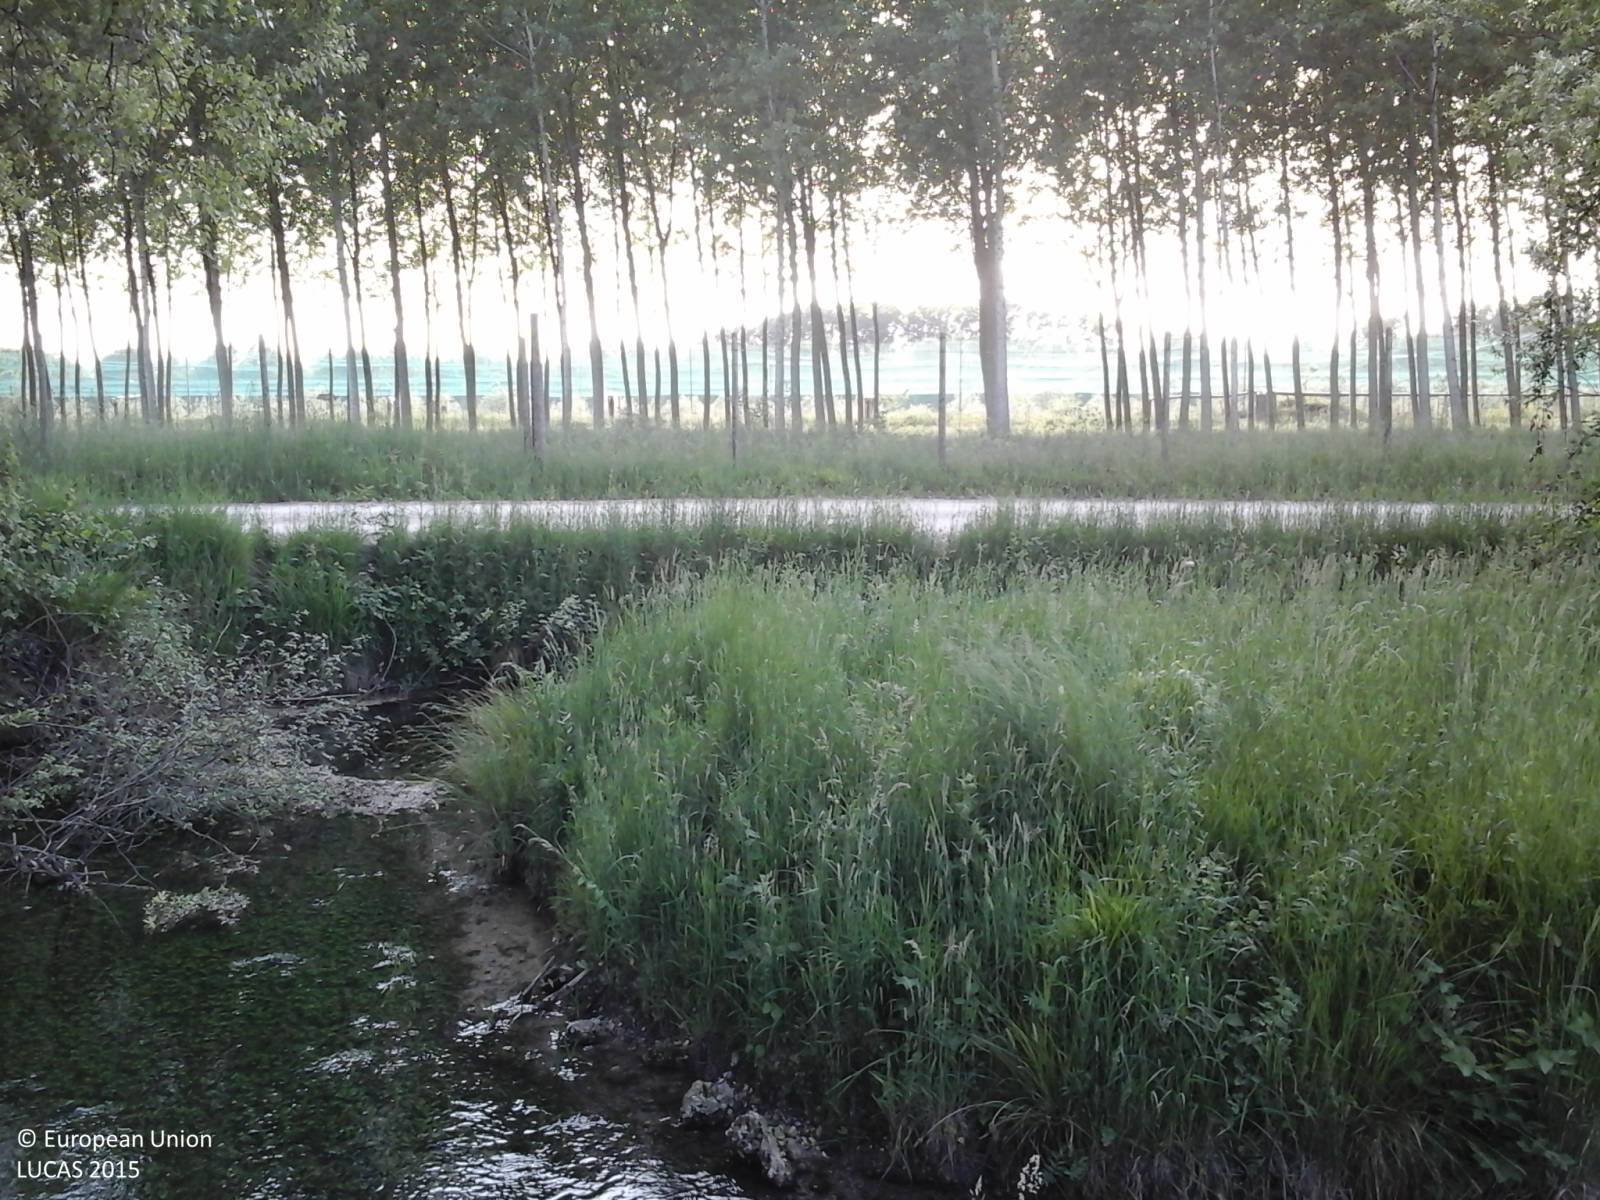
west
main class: Woodland
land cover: Broadleaved woodland
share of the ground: > 75 %
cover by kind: broadleaved forest trees 90 %, herbaceous plants 10 %
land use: Semi-natural and natural areas not in use
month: May
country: IT
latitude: 45.9119
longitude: 13.0259
